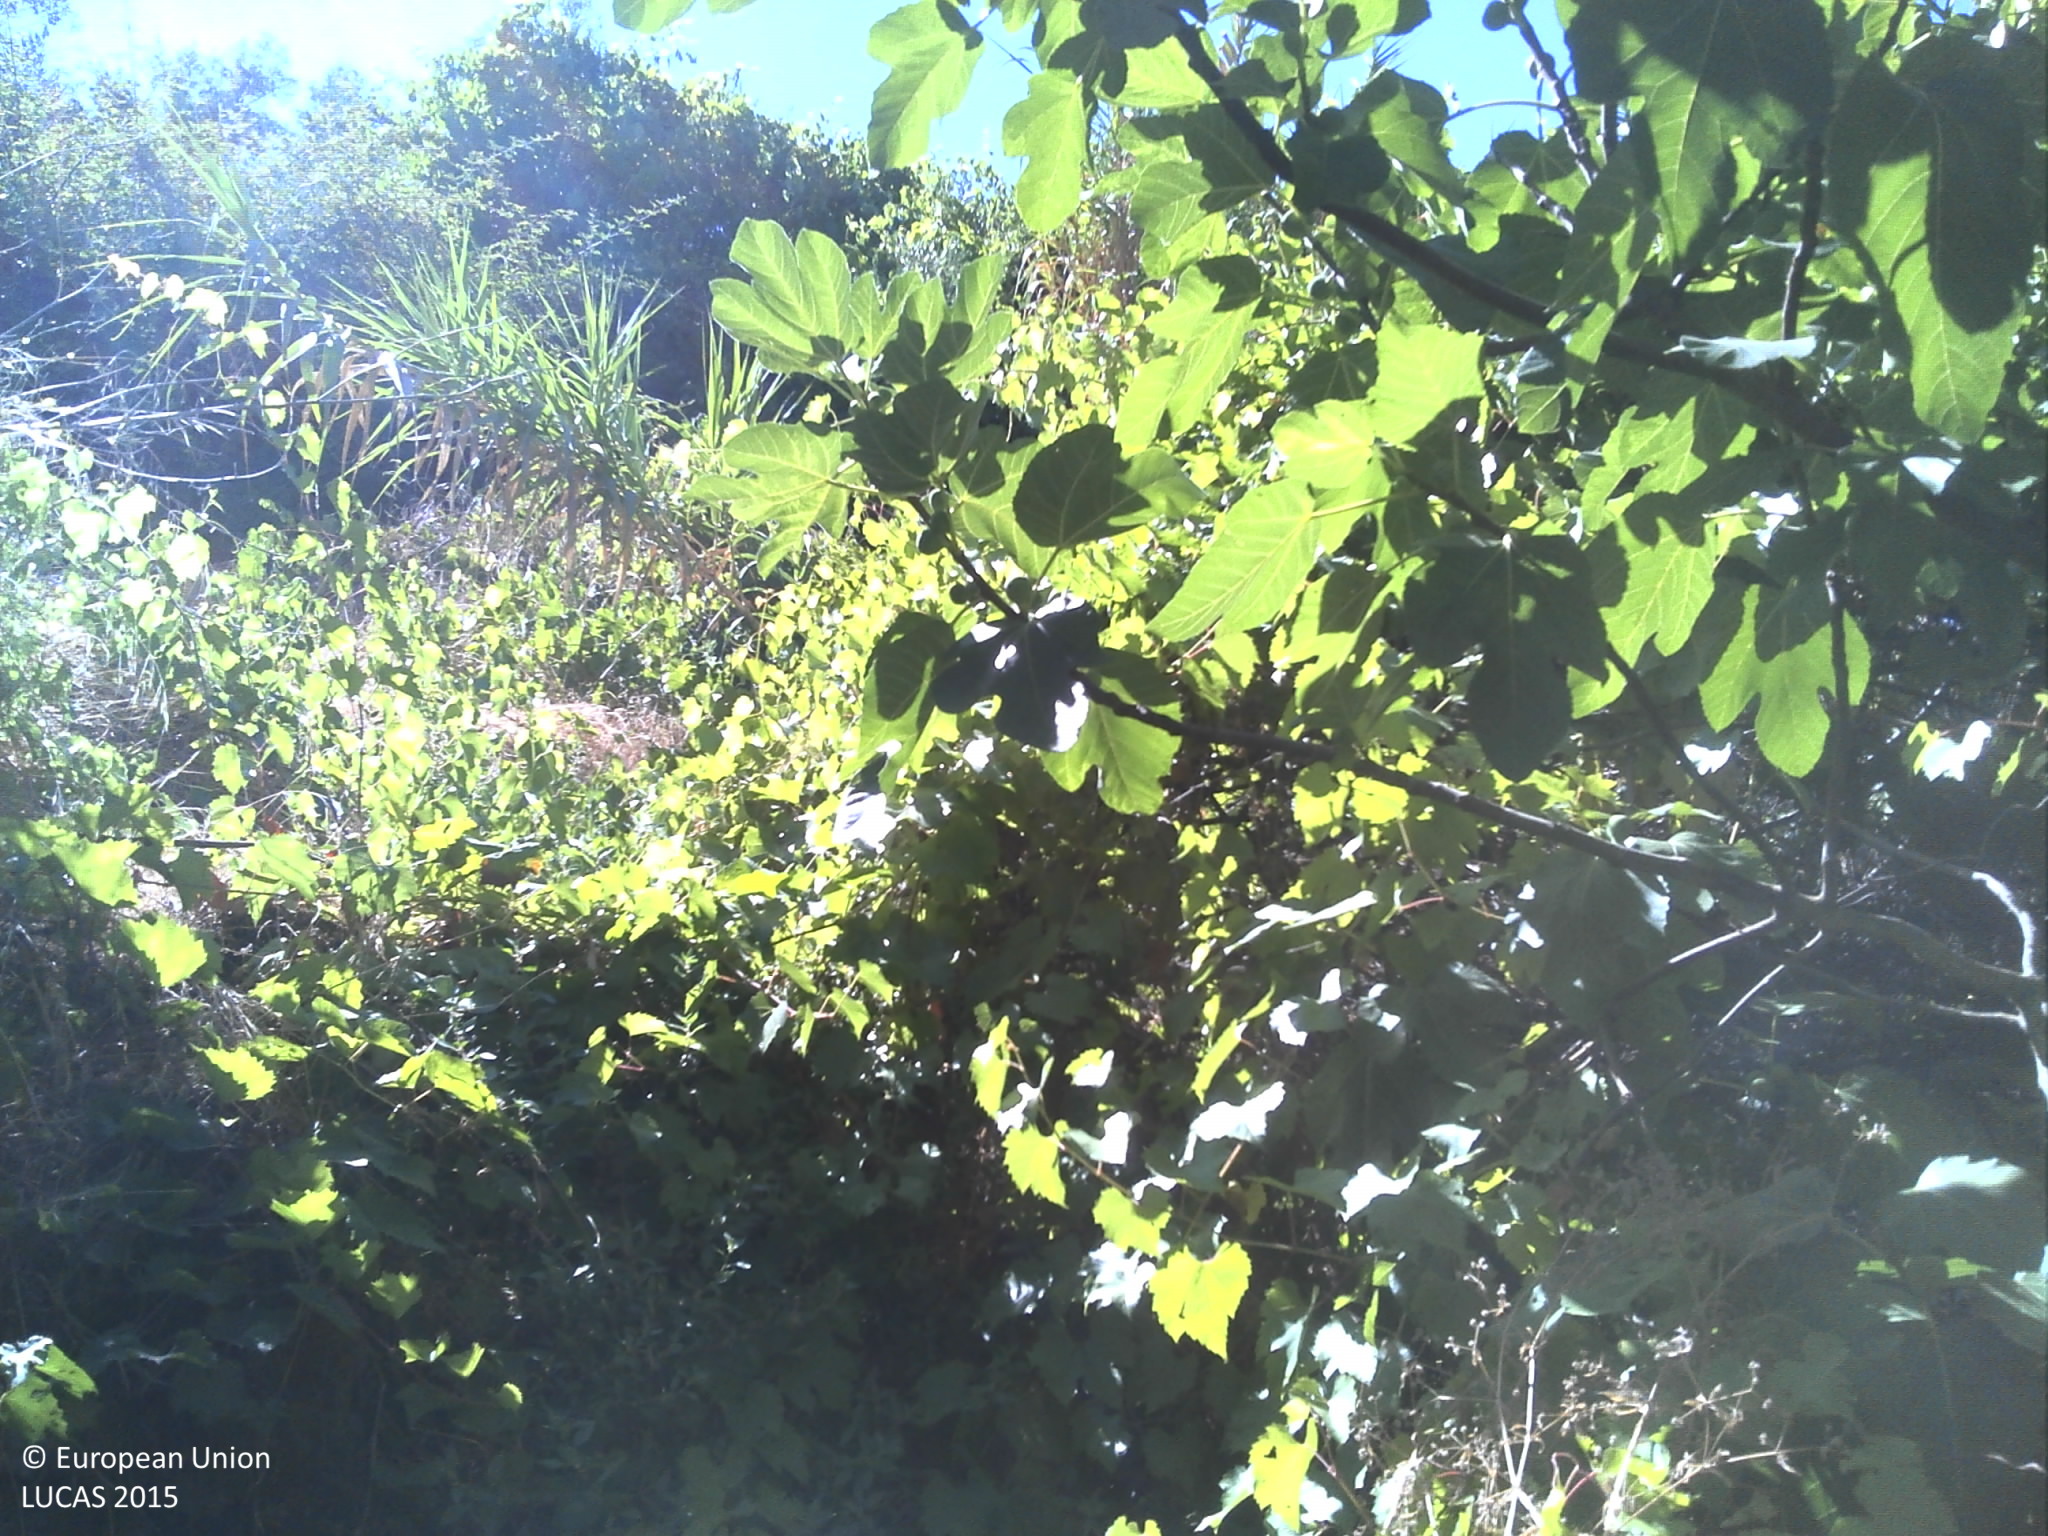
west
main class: Cropland
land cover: Olive groves
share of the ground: < 10 %
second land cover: Grassland without tree/shrub cover
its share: > 75 %
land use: Agriculture (excluding fallow land and kitchen gardens)
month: July
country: PT
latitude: 41.3038
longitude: -7.3794
